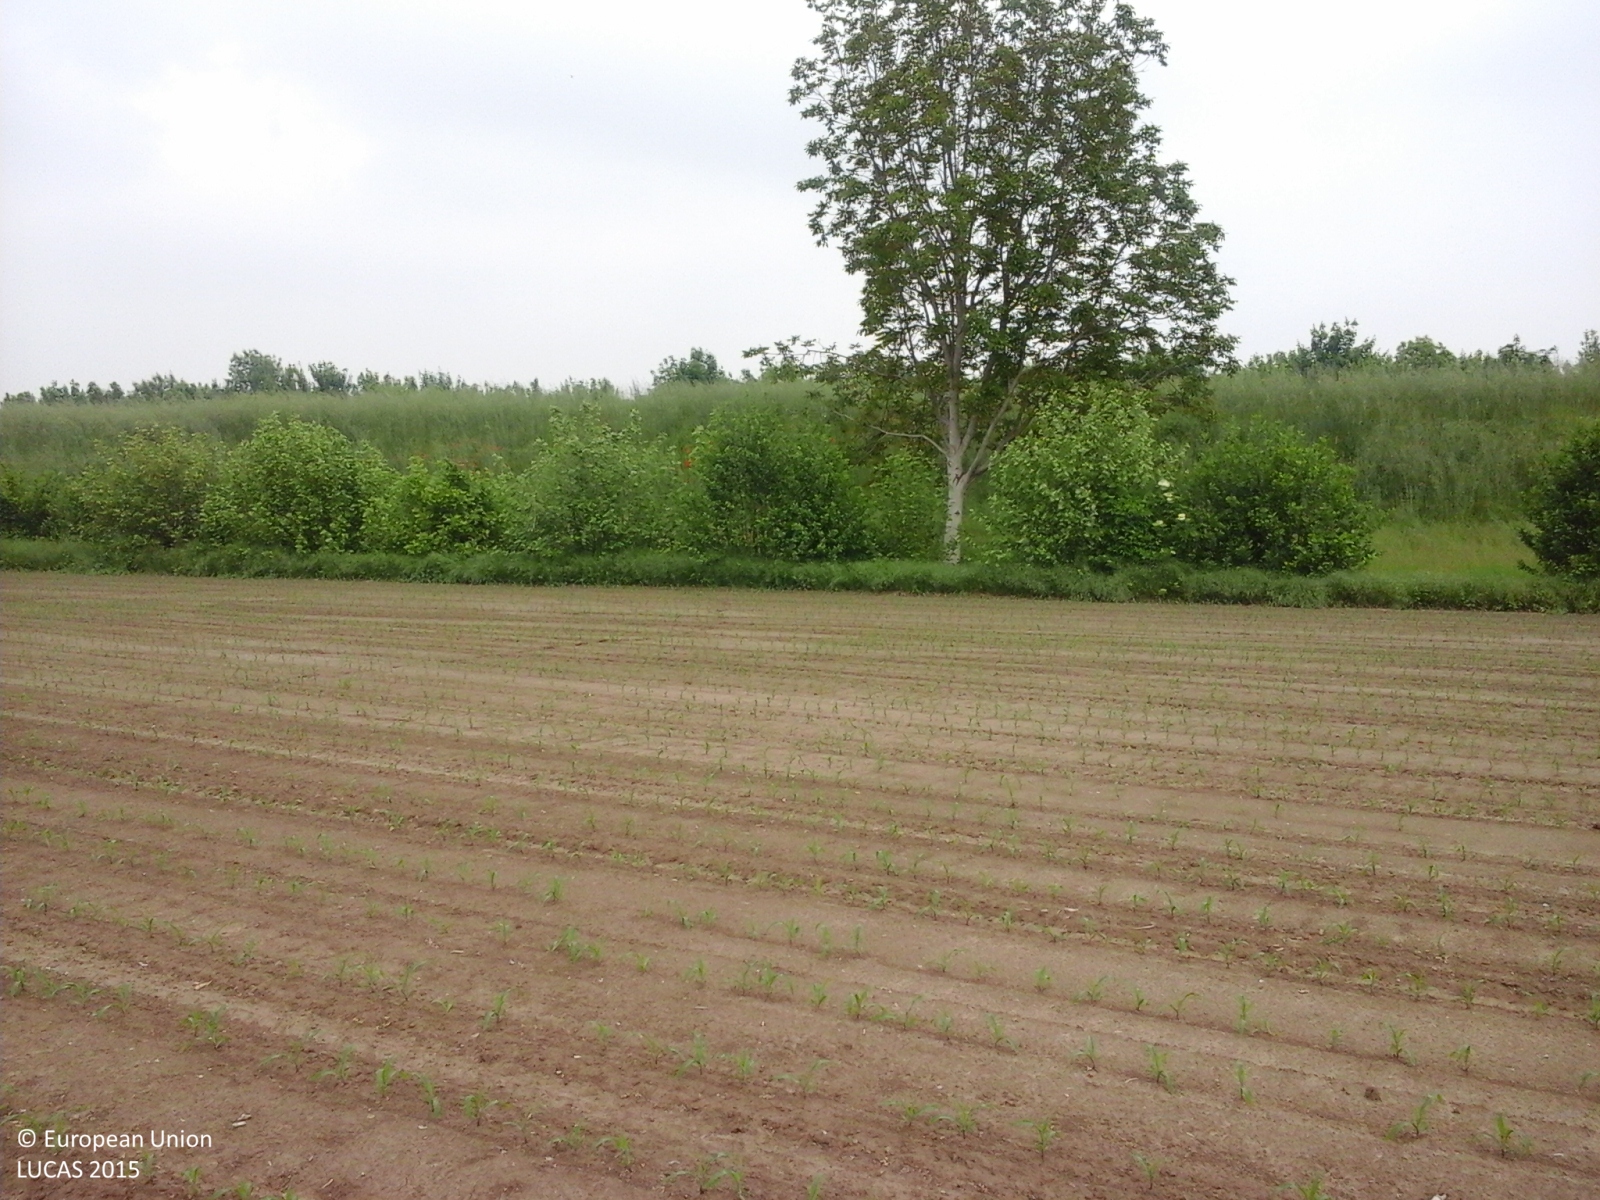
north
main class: Cropland
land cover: Maize
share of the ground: < 10 %
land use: Agriculture (excluding fallow land and kitchen gardens)
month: May
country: IT
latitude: 45.0717
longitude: 10.1648
